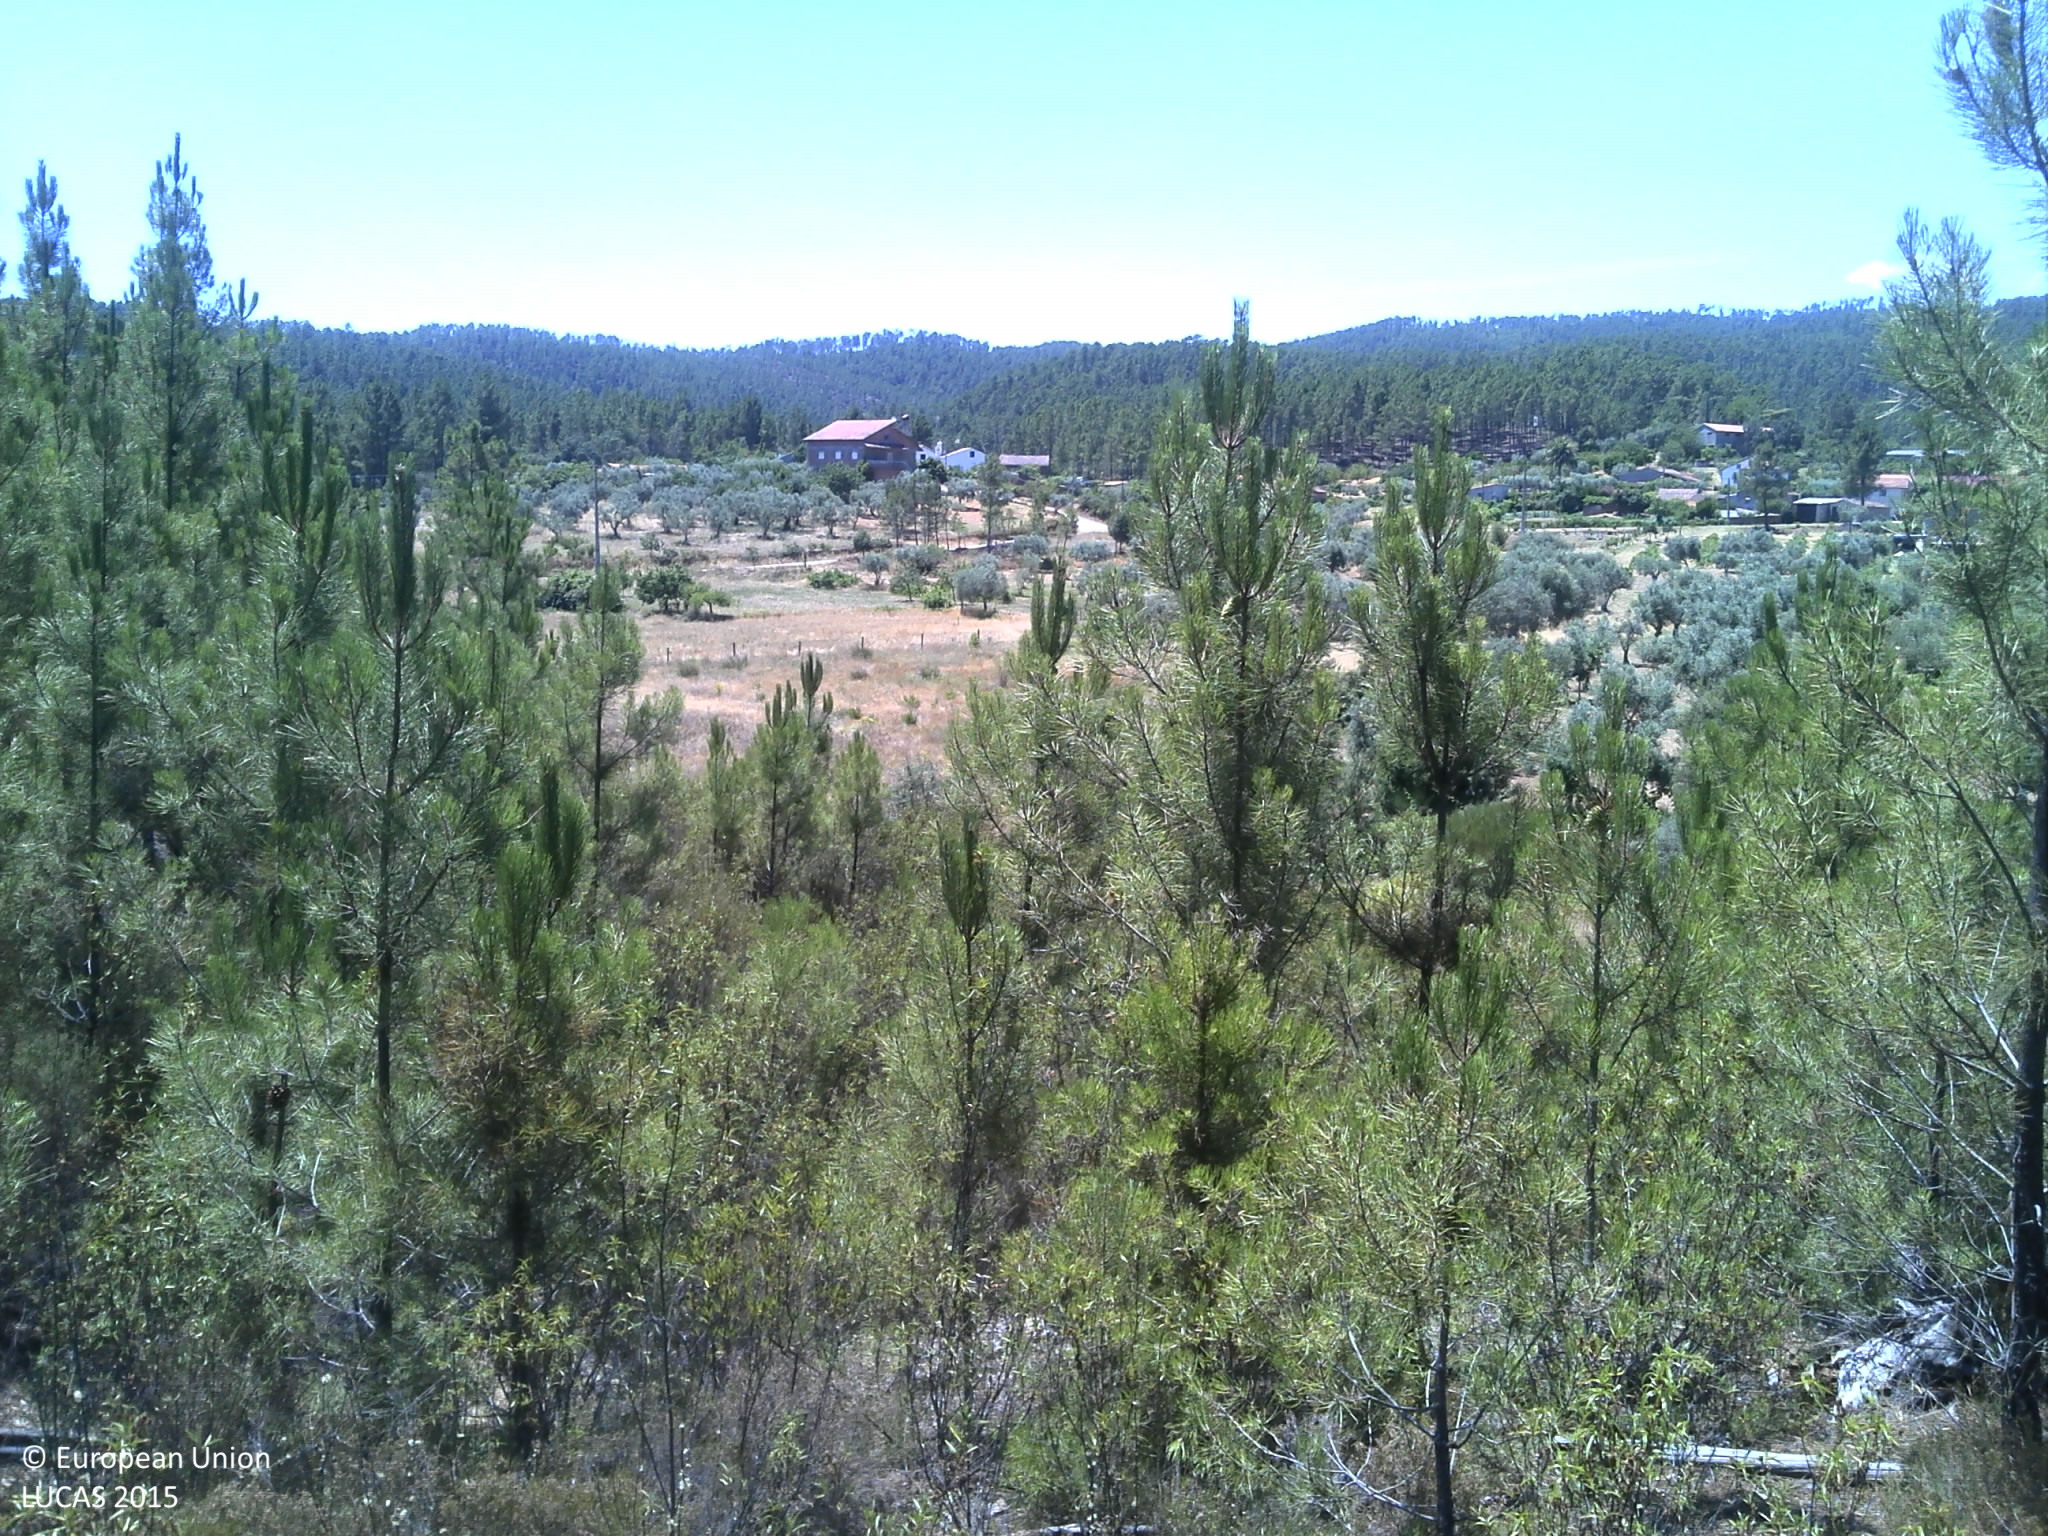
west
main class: Woodland
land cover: Pine dominated coniferous woodland
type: coniferous forest of the mediterranean region
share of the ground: 10 - 25 %
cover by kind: shrubs 75 %, coniferous forest trees 15 %, unconsolidated bare surface 10 %
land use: Forestry
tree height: < 5 m
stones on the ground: 10 - 25 %
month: July
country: PT
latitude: 39.9413
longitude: -7.6722
